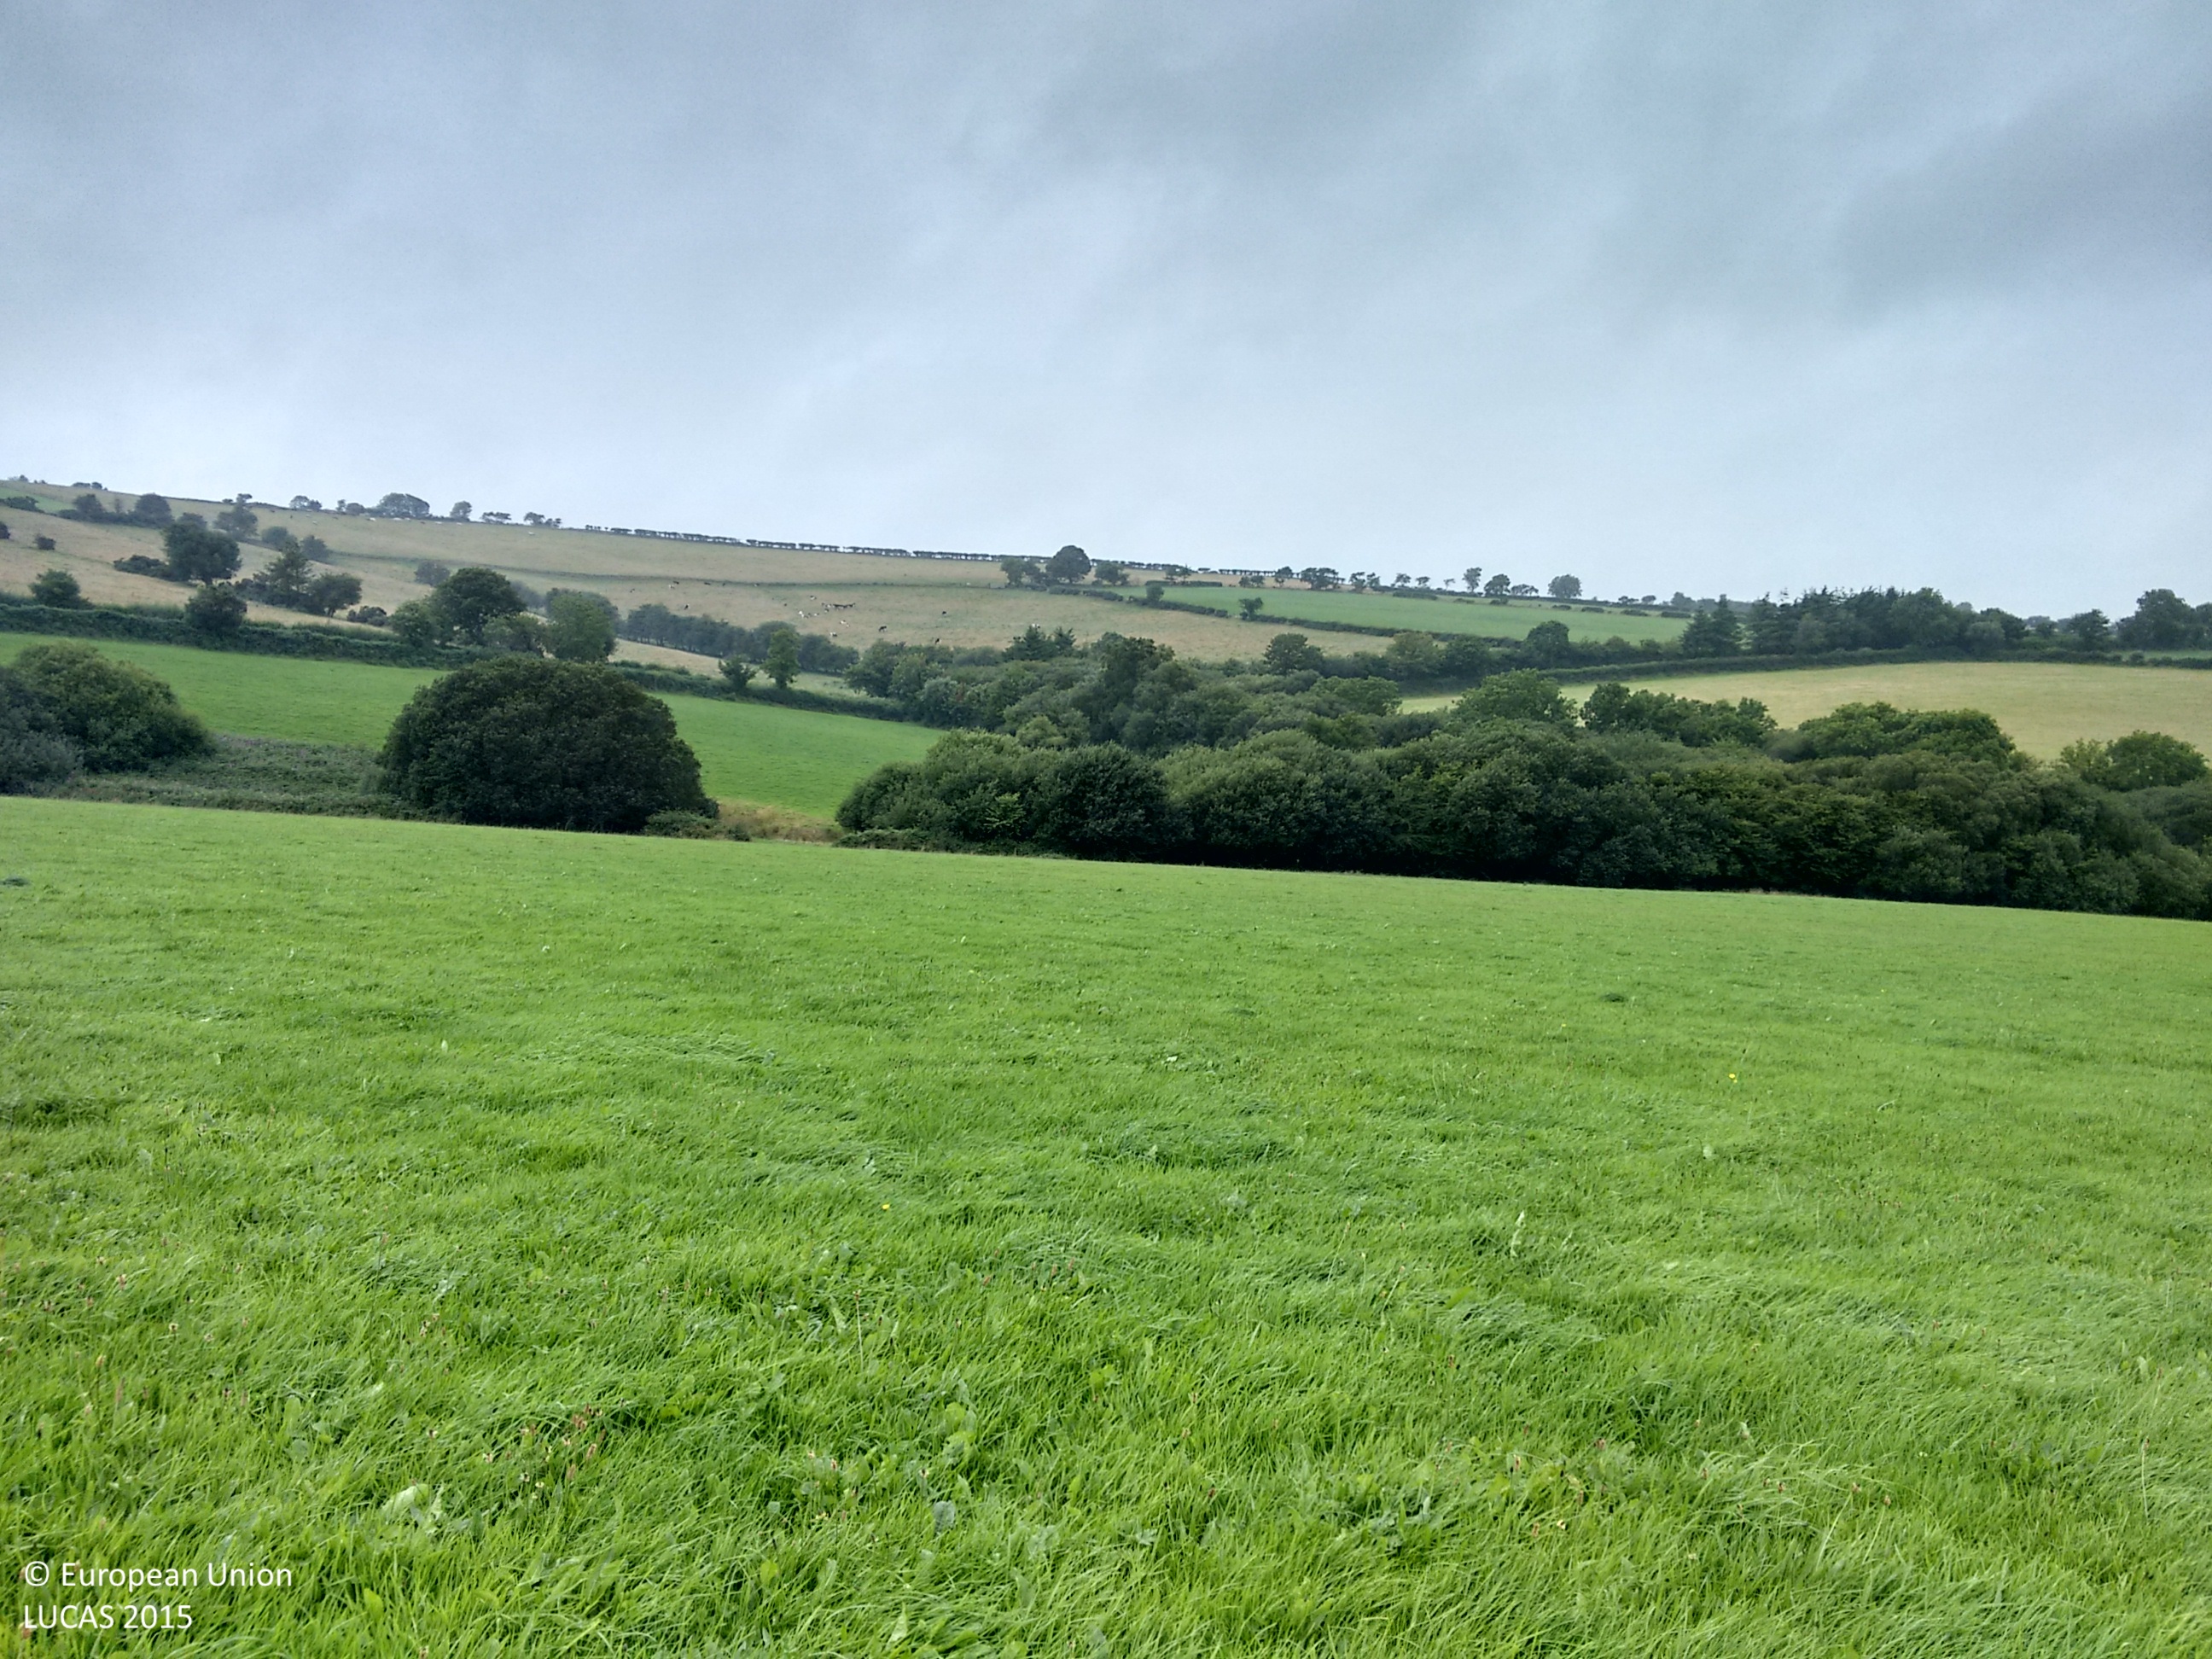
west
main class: Grassland
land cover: Grassland without tree/shrub cover
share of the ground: > 75 %
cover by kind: herbaceous plants 100 %
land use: Agriculture (excluding fallow land and kitchen gardens)
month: August
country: GB
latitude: 52.0162
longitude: -4.4570
